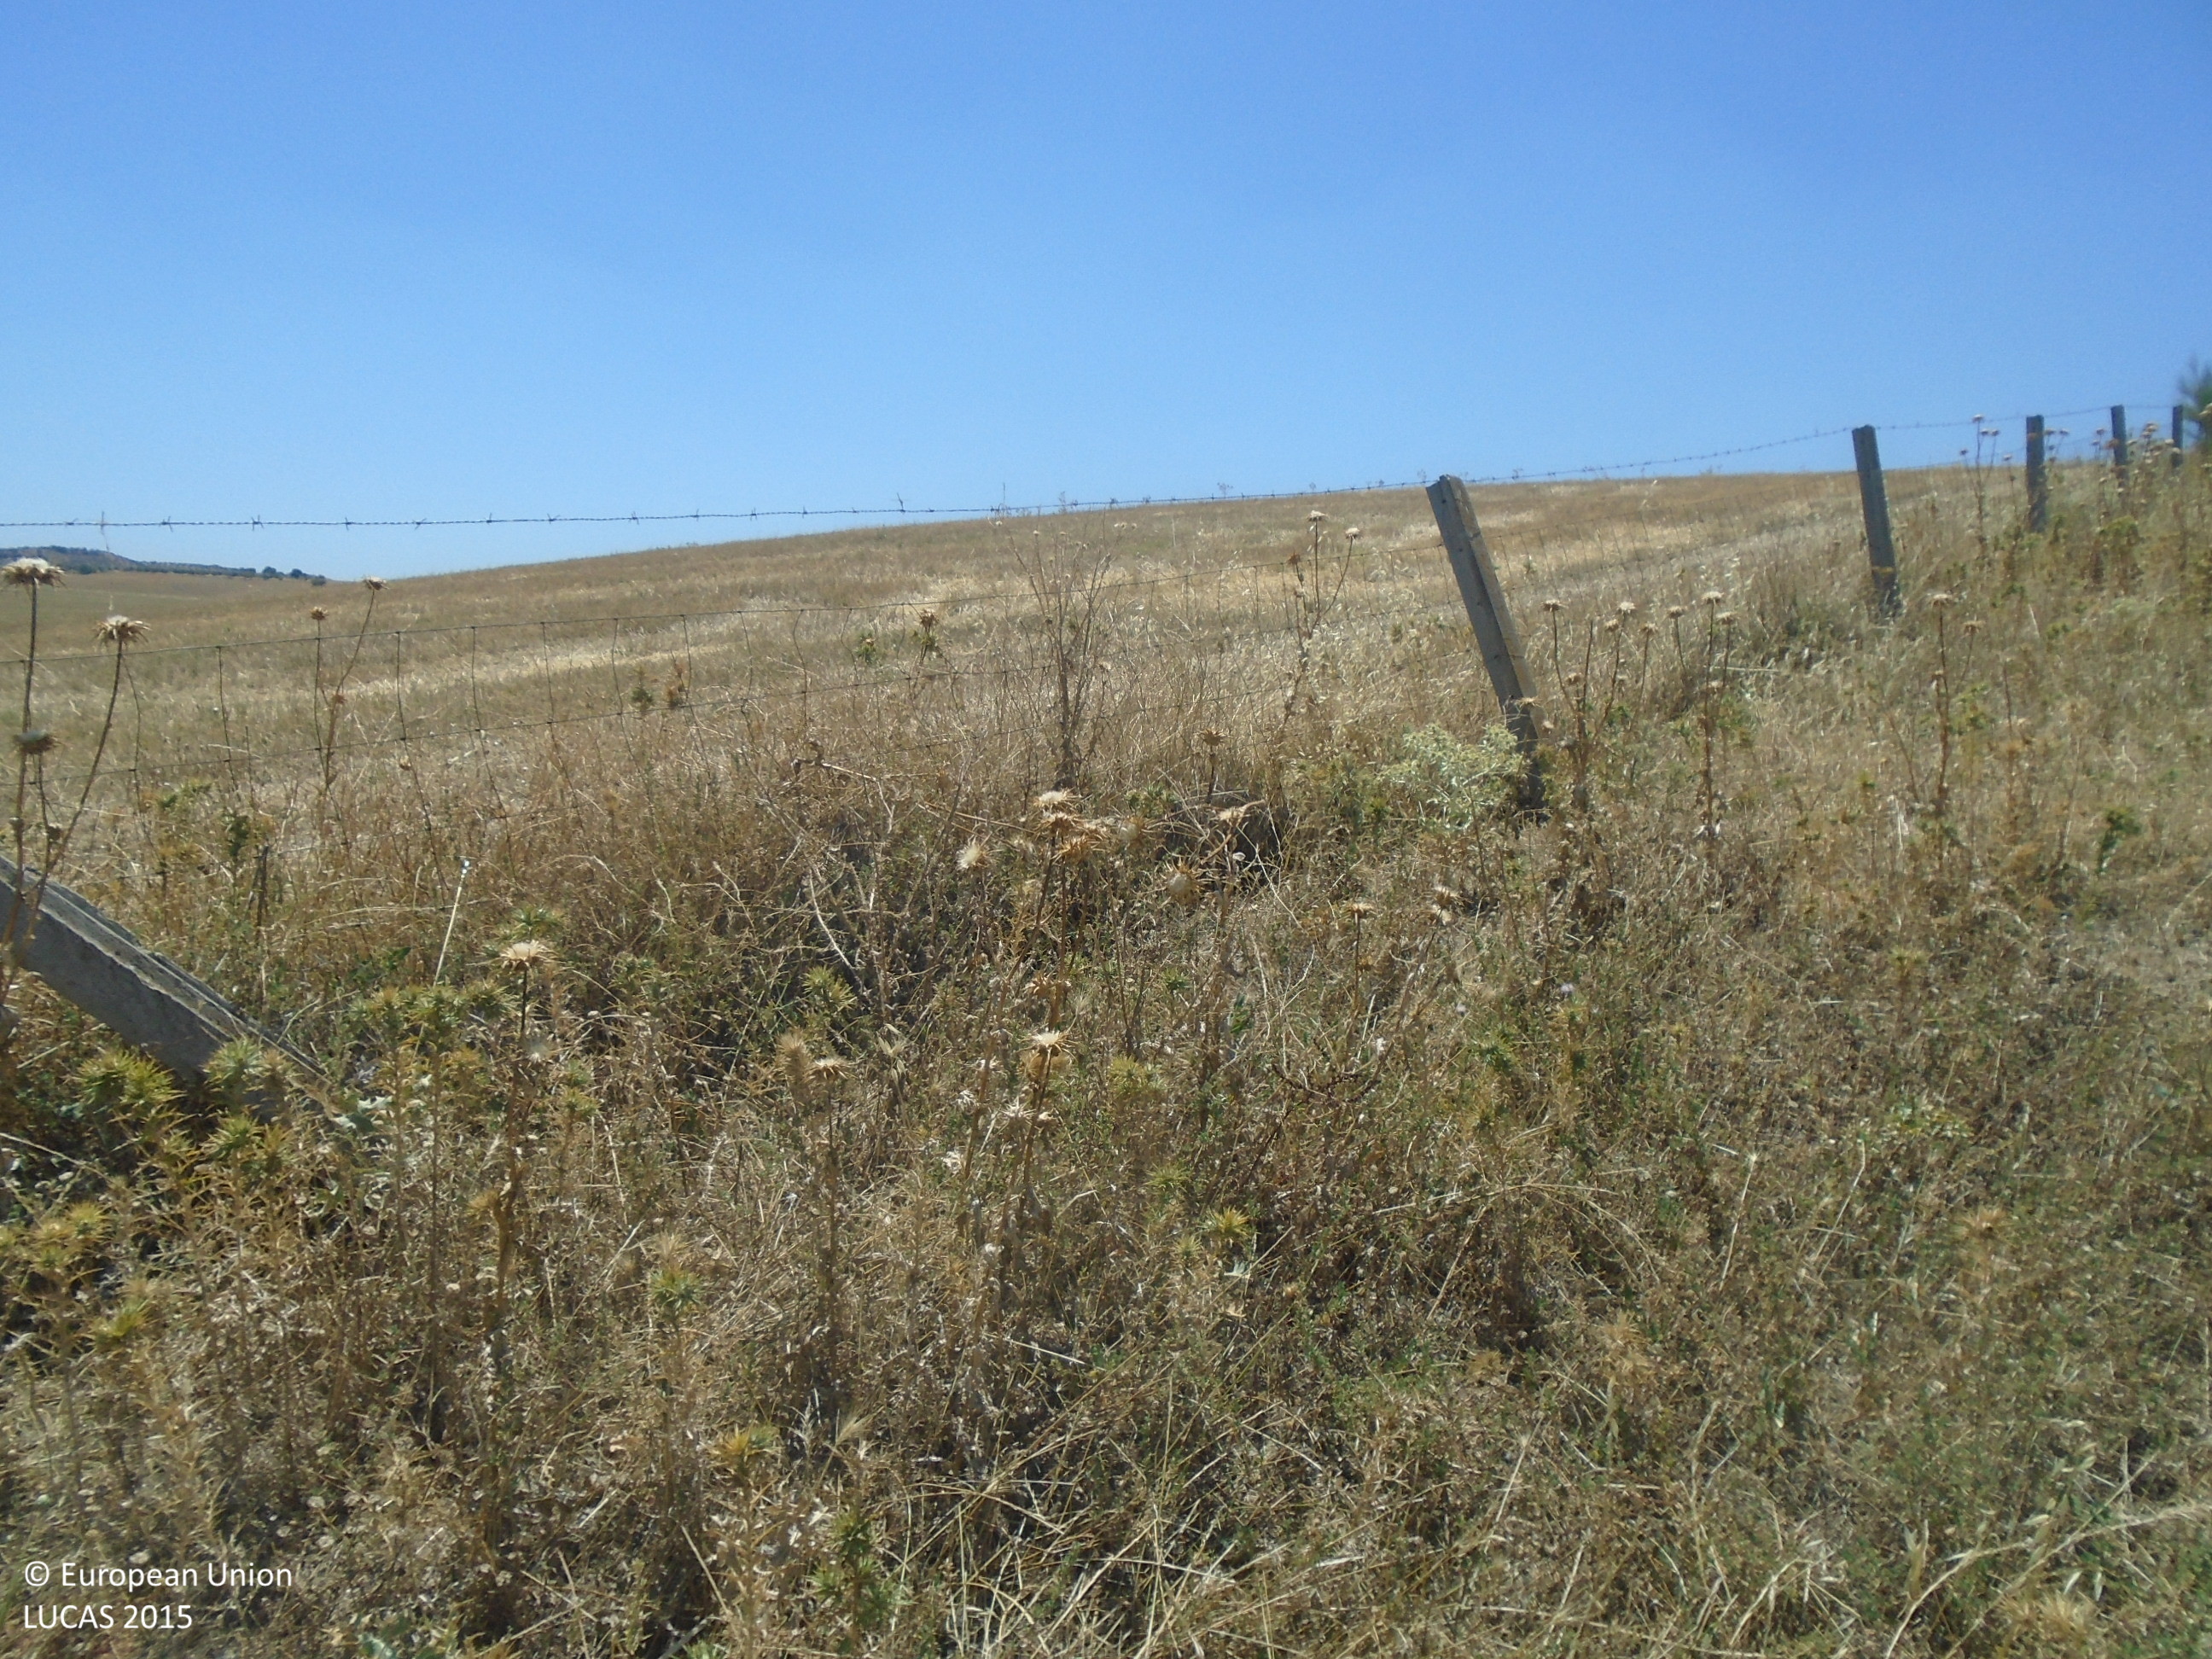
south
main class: Cropland
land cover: Common wheat
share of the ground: > 75 %
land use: Agriculture (excluding fallow land and kitchen gardens)
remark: Harvested field
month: July
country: ES
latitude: 39.7784
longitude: -4.9331
